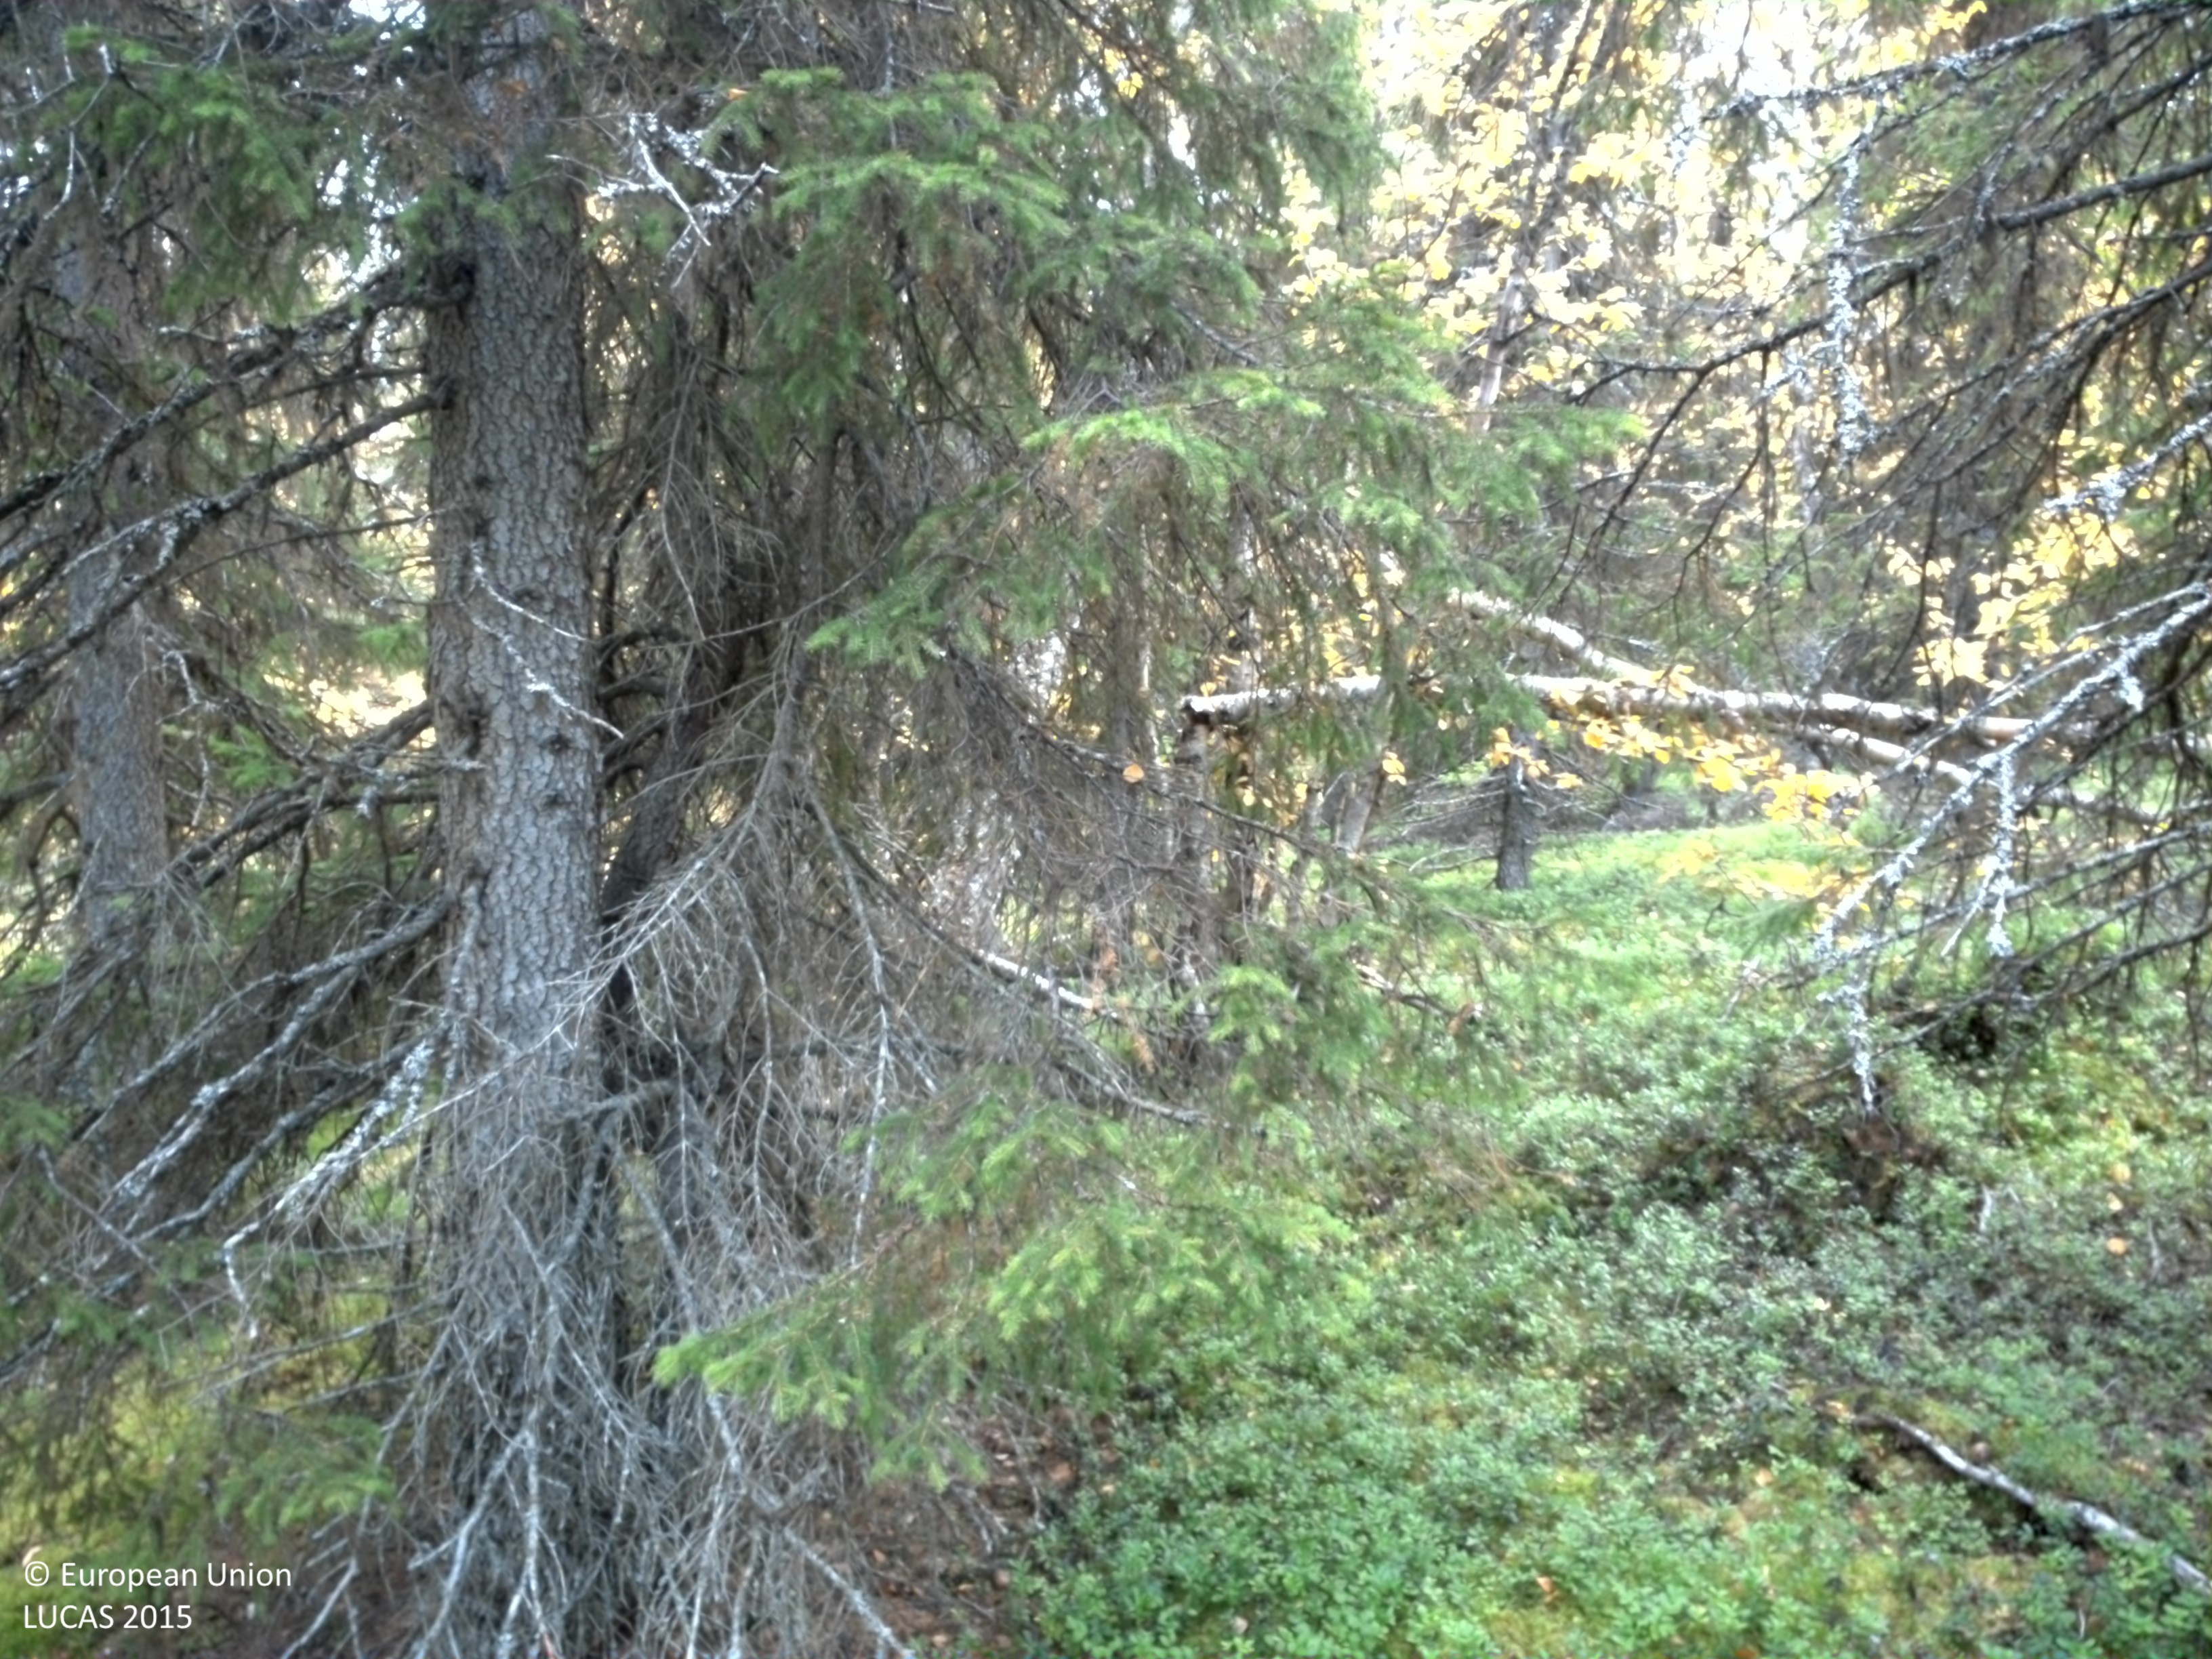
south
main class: Woodland
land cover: Spruce dominated mixed woodland
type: boreal forest
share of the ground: 25 - 50 %
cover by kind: shrubs 35 %, lichens and mosses 30 %, coniferous forest trees 20 %, broadleaved forest trees 10 %, herbaceous plants 5 %
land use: Forestry
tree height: > 5 m
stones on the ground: 10 - 25 %
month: September
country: SE
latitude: 65.1462
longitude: 16.6802
